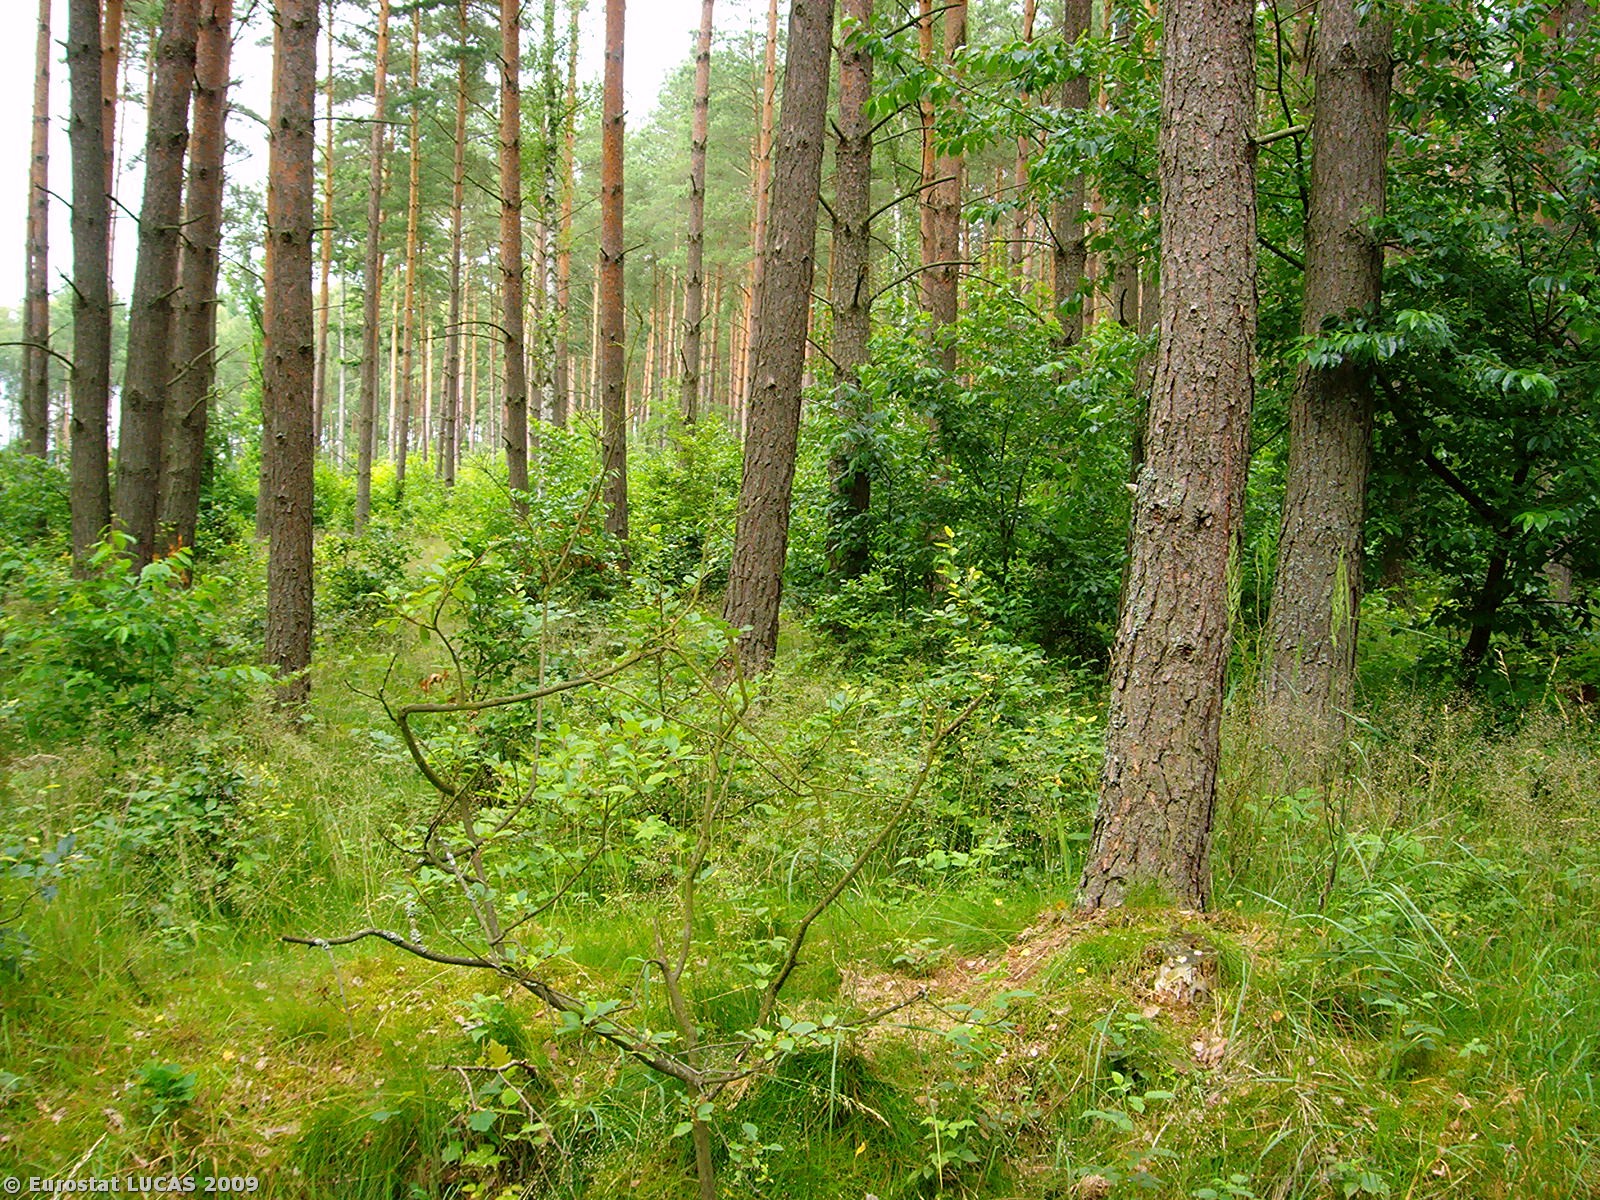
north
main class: Woodland
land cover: Mixed woodland
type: hemiboreal forest and nemoral coniferous forest and mixed broadleaved-coniferous forest
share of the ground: 50 - 75 %
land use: Forestry
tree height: > 5 m
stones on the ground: < 10 %
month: June
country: PL
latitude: 53.2243
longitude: 15.4705
